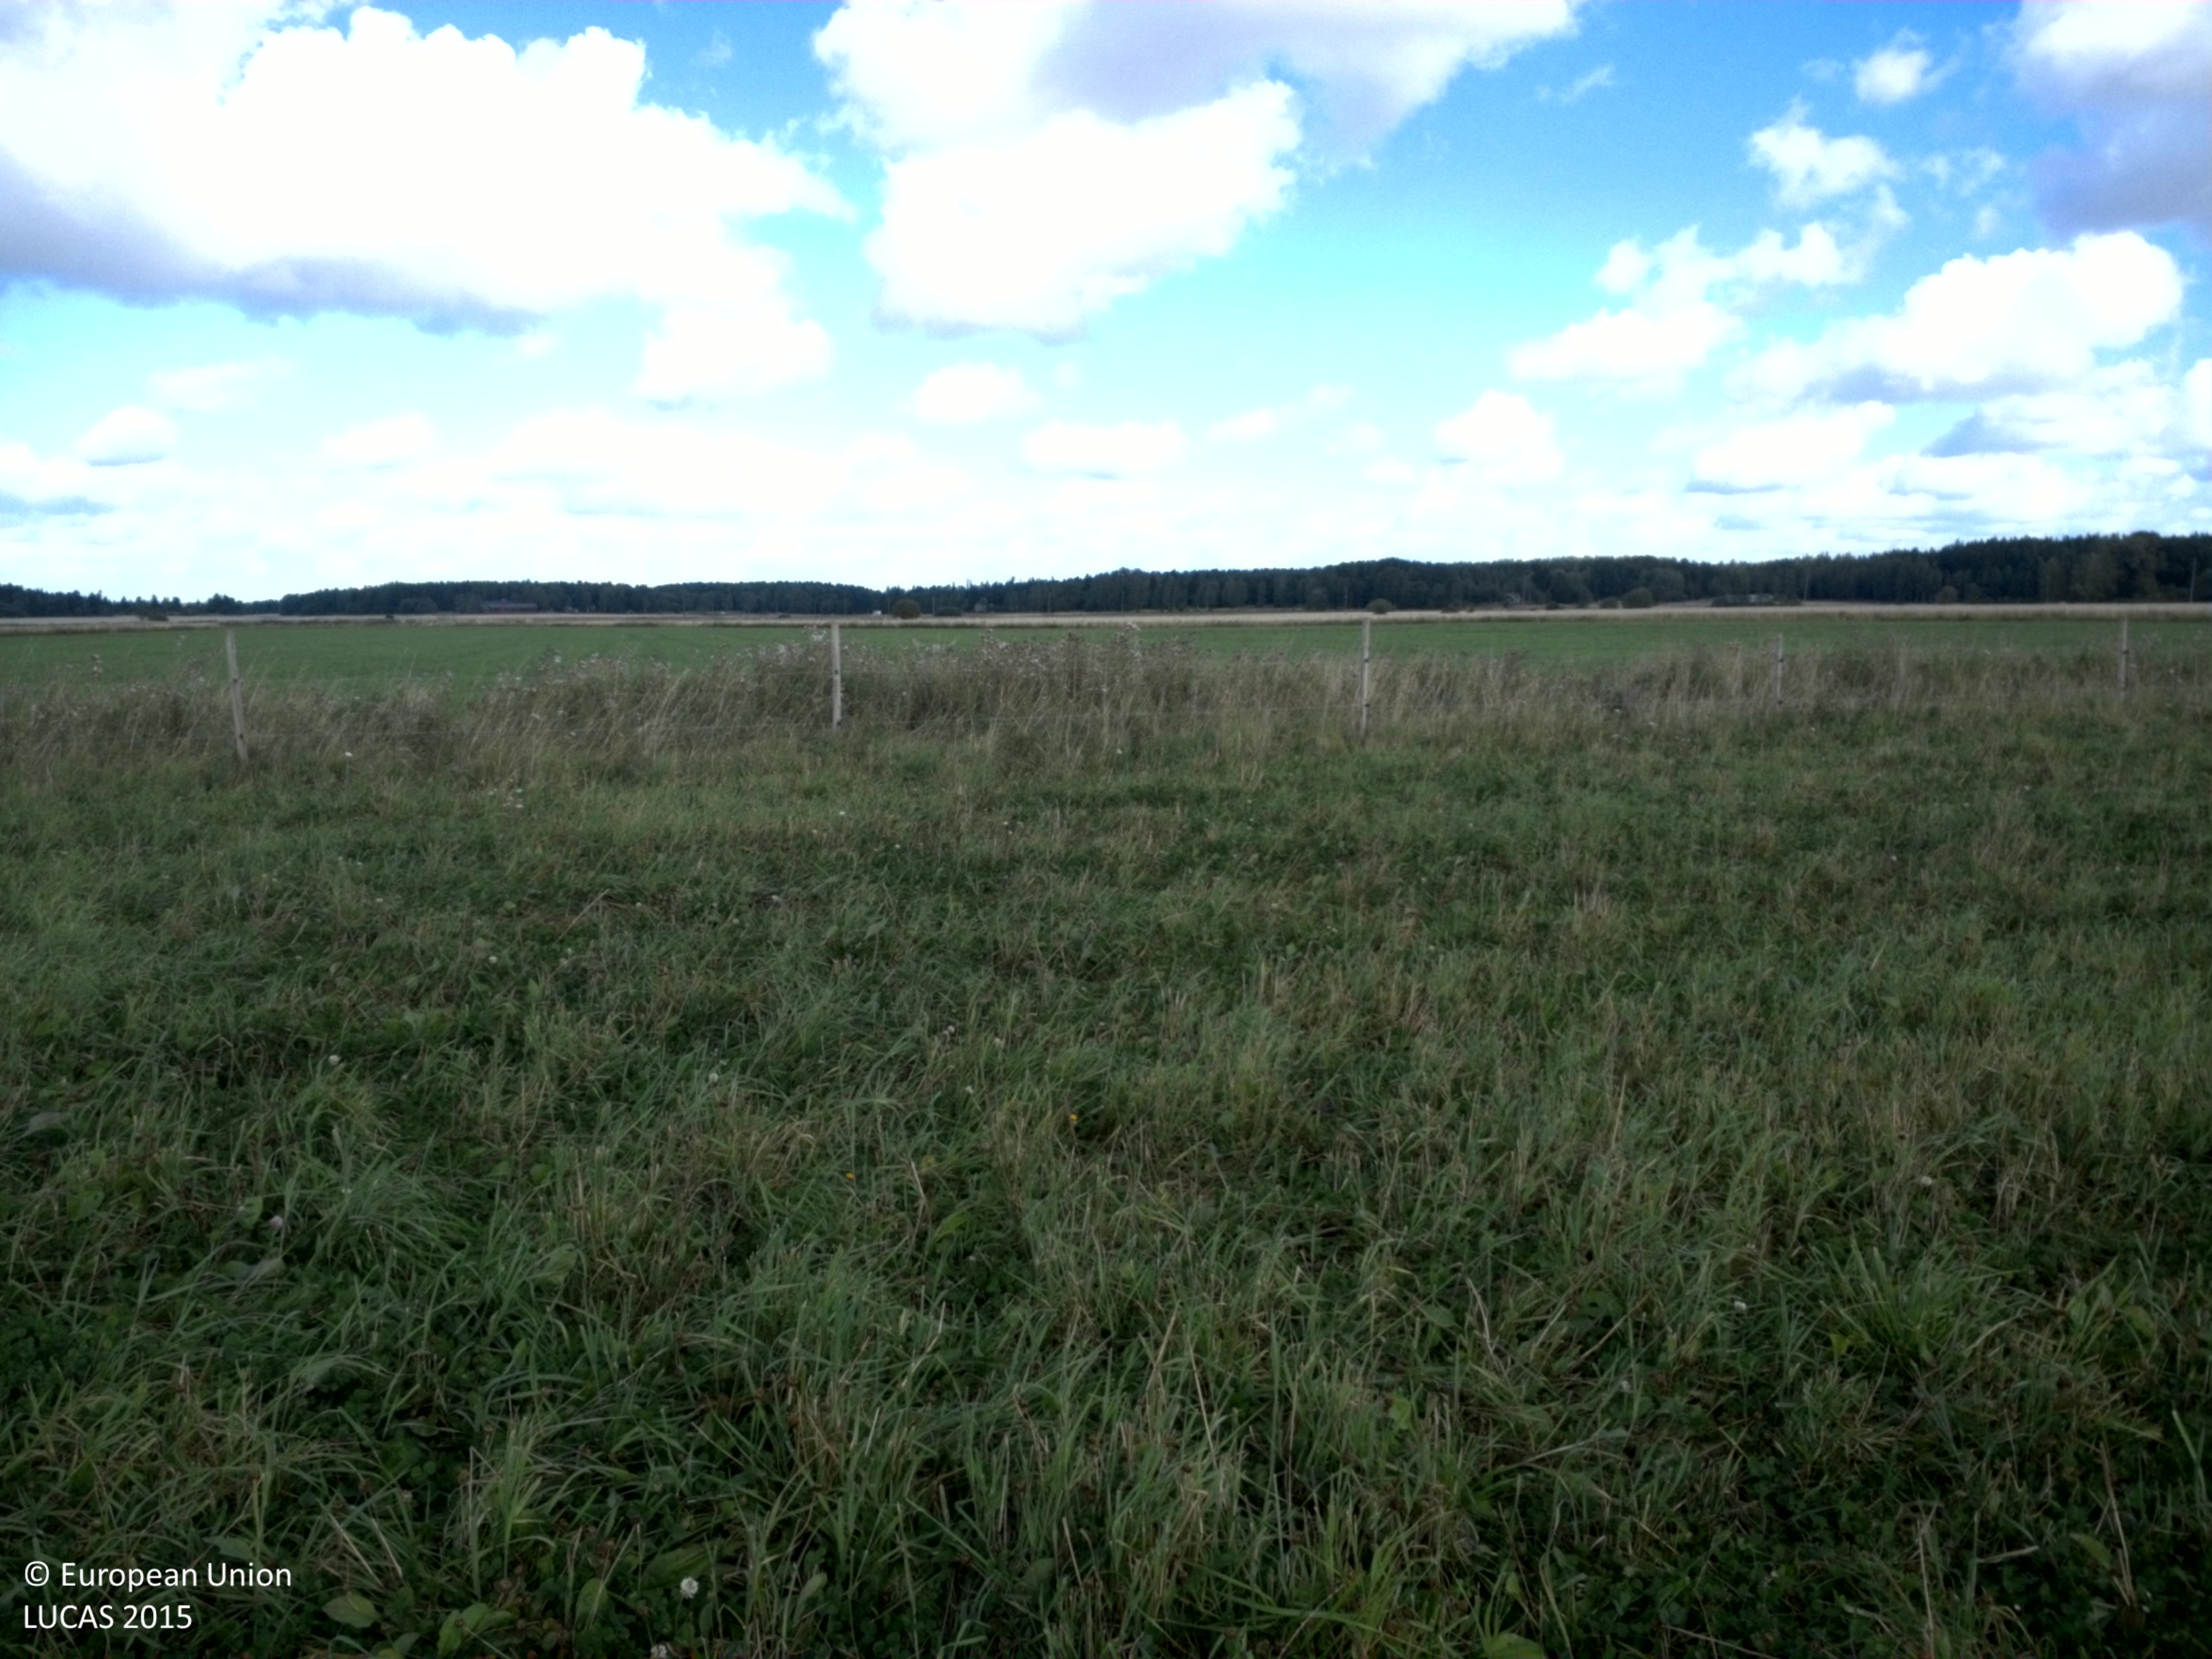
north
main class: Grassland
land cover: Grassland without tree/shrub cover
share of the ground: > 75 %
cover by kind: herbaceous plants 100 %
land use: Agriculture (excluding fallow land and kitchen gardens)
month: August
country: SE
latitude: 59.7007
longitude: 16.9764
